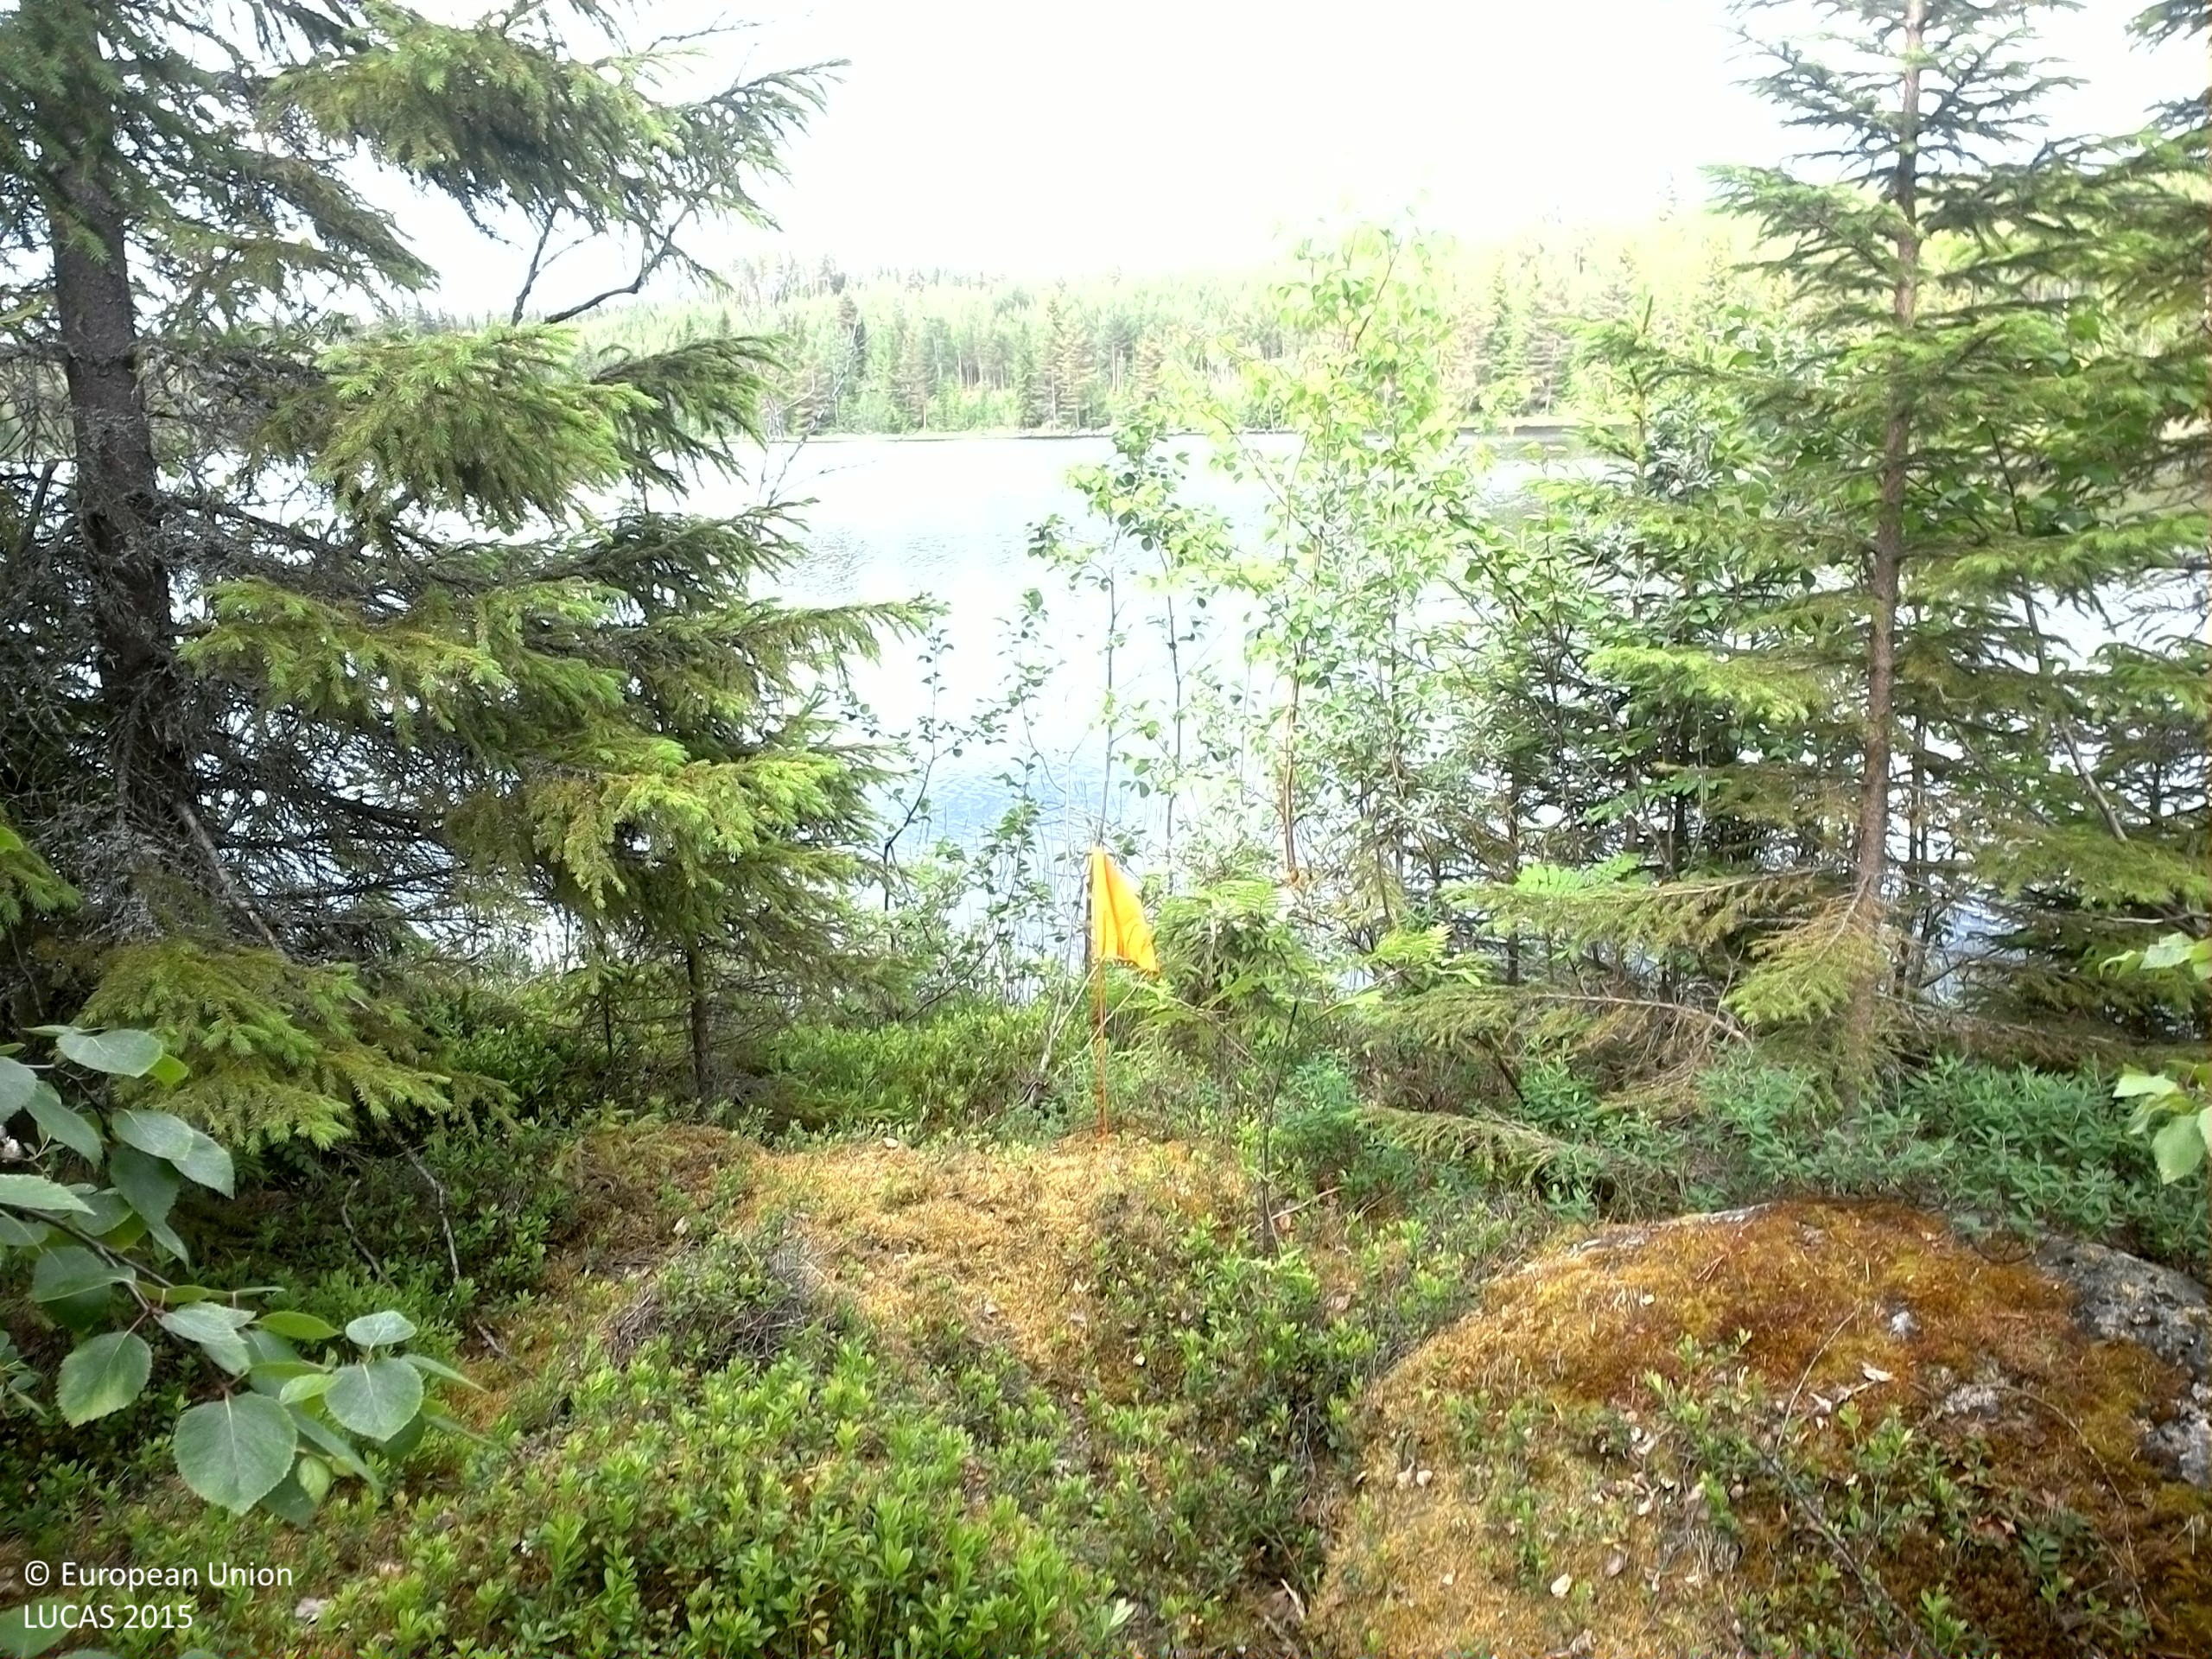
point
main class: Woodland
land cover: Spruce dominated mixed woodland
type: boreal forest
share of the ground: > 75 %
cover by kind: coniferous forest trees 60 %, broadleaved forest trees 30 %, shrubs 10 %
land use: Forestry
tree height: < 5 m
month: July
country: SE
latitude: 63.5864
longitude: 17.8520
